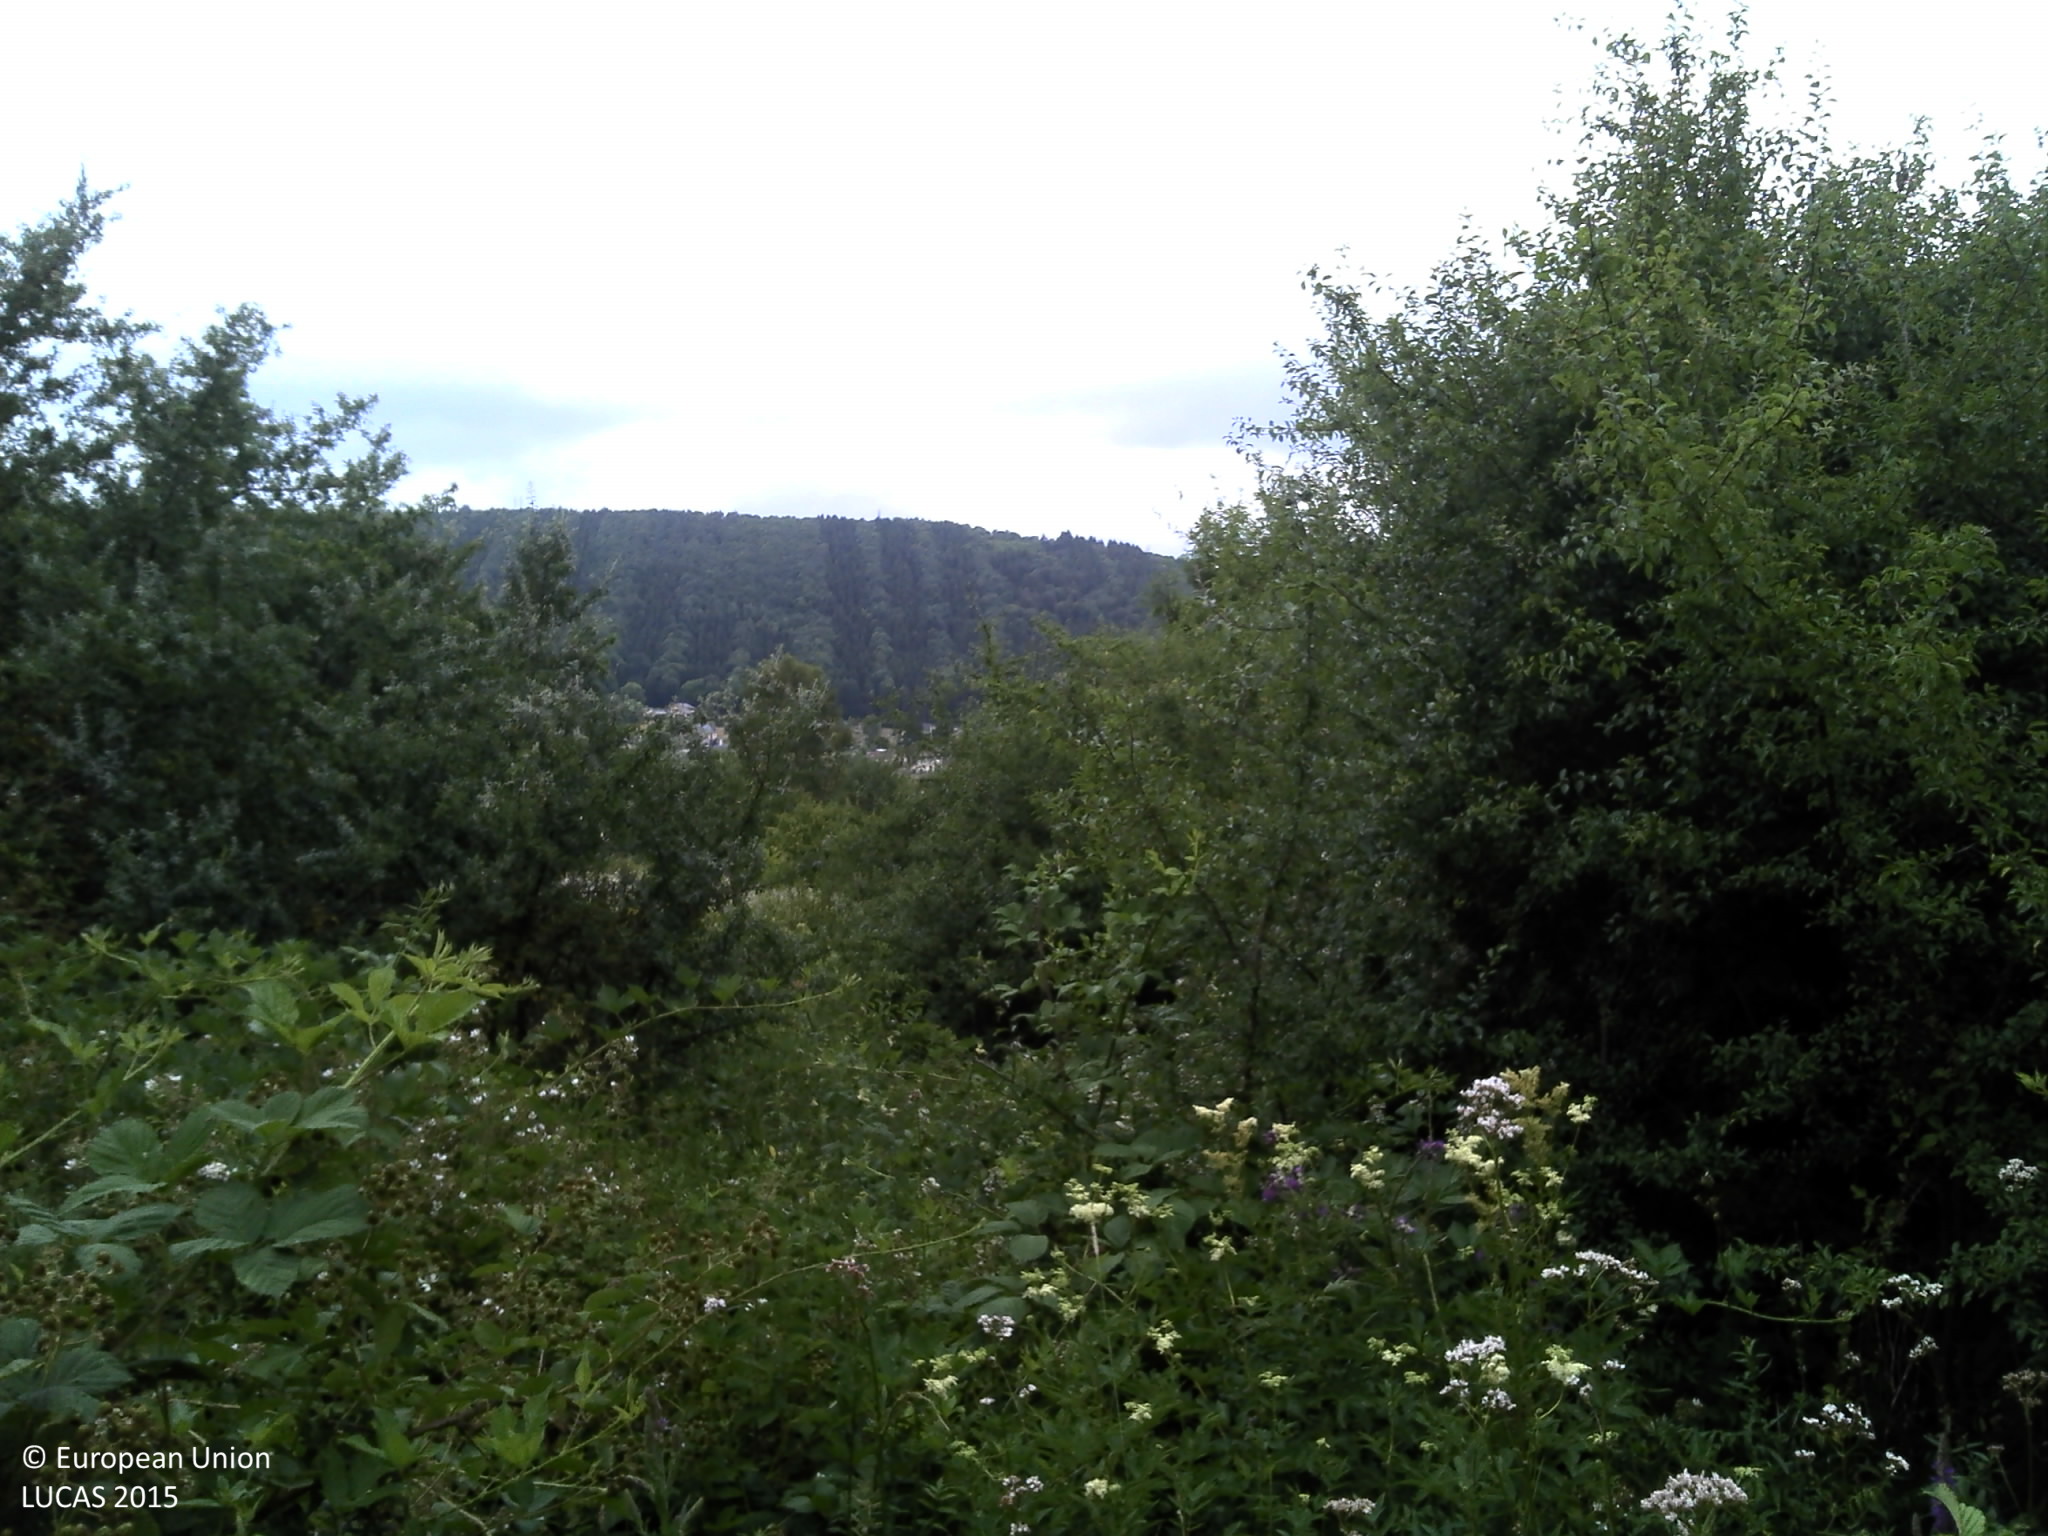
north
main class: Shrubland
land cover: Shrubland with sparse tree cover
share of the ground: > 75 %
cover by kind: herbaceous plants 80 %, shrubs 15 %, broadleaved forest trees 5 %
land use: Semi-natural and natural areas not in use
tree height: > 5 m
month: July
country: FR
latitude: 49.8101
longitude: 4.7300
